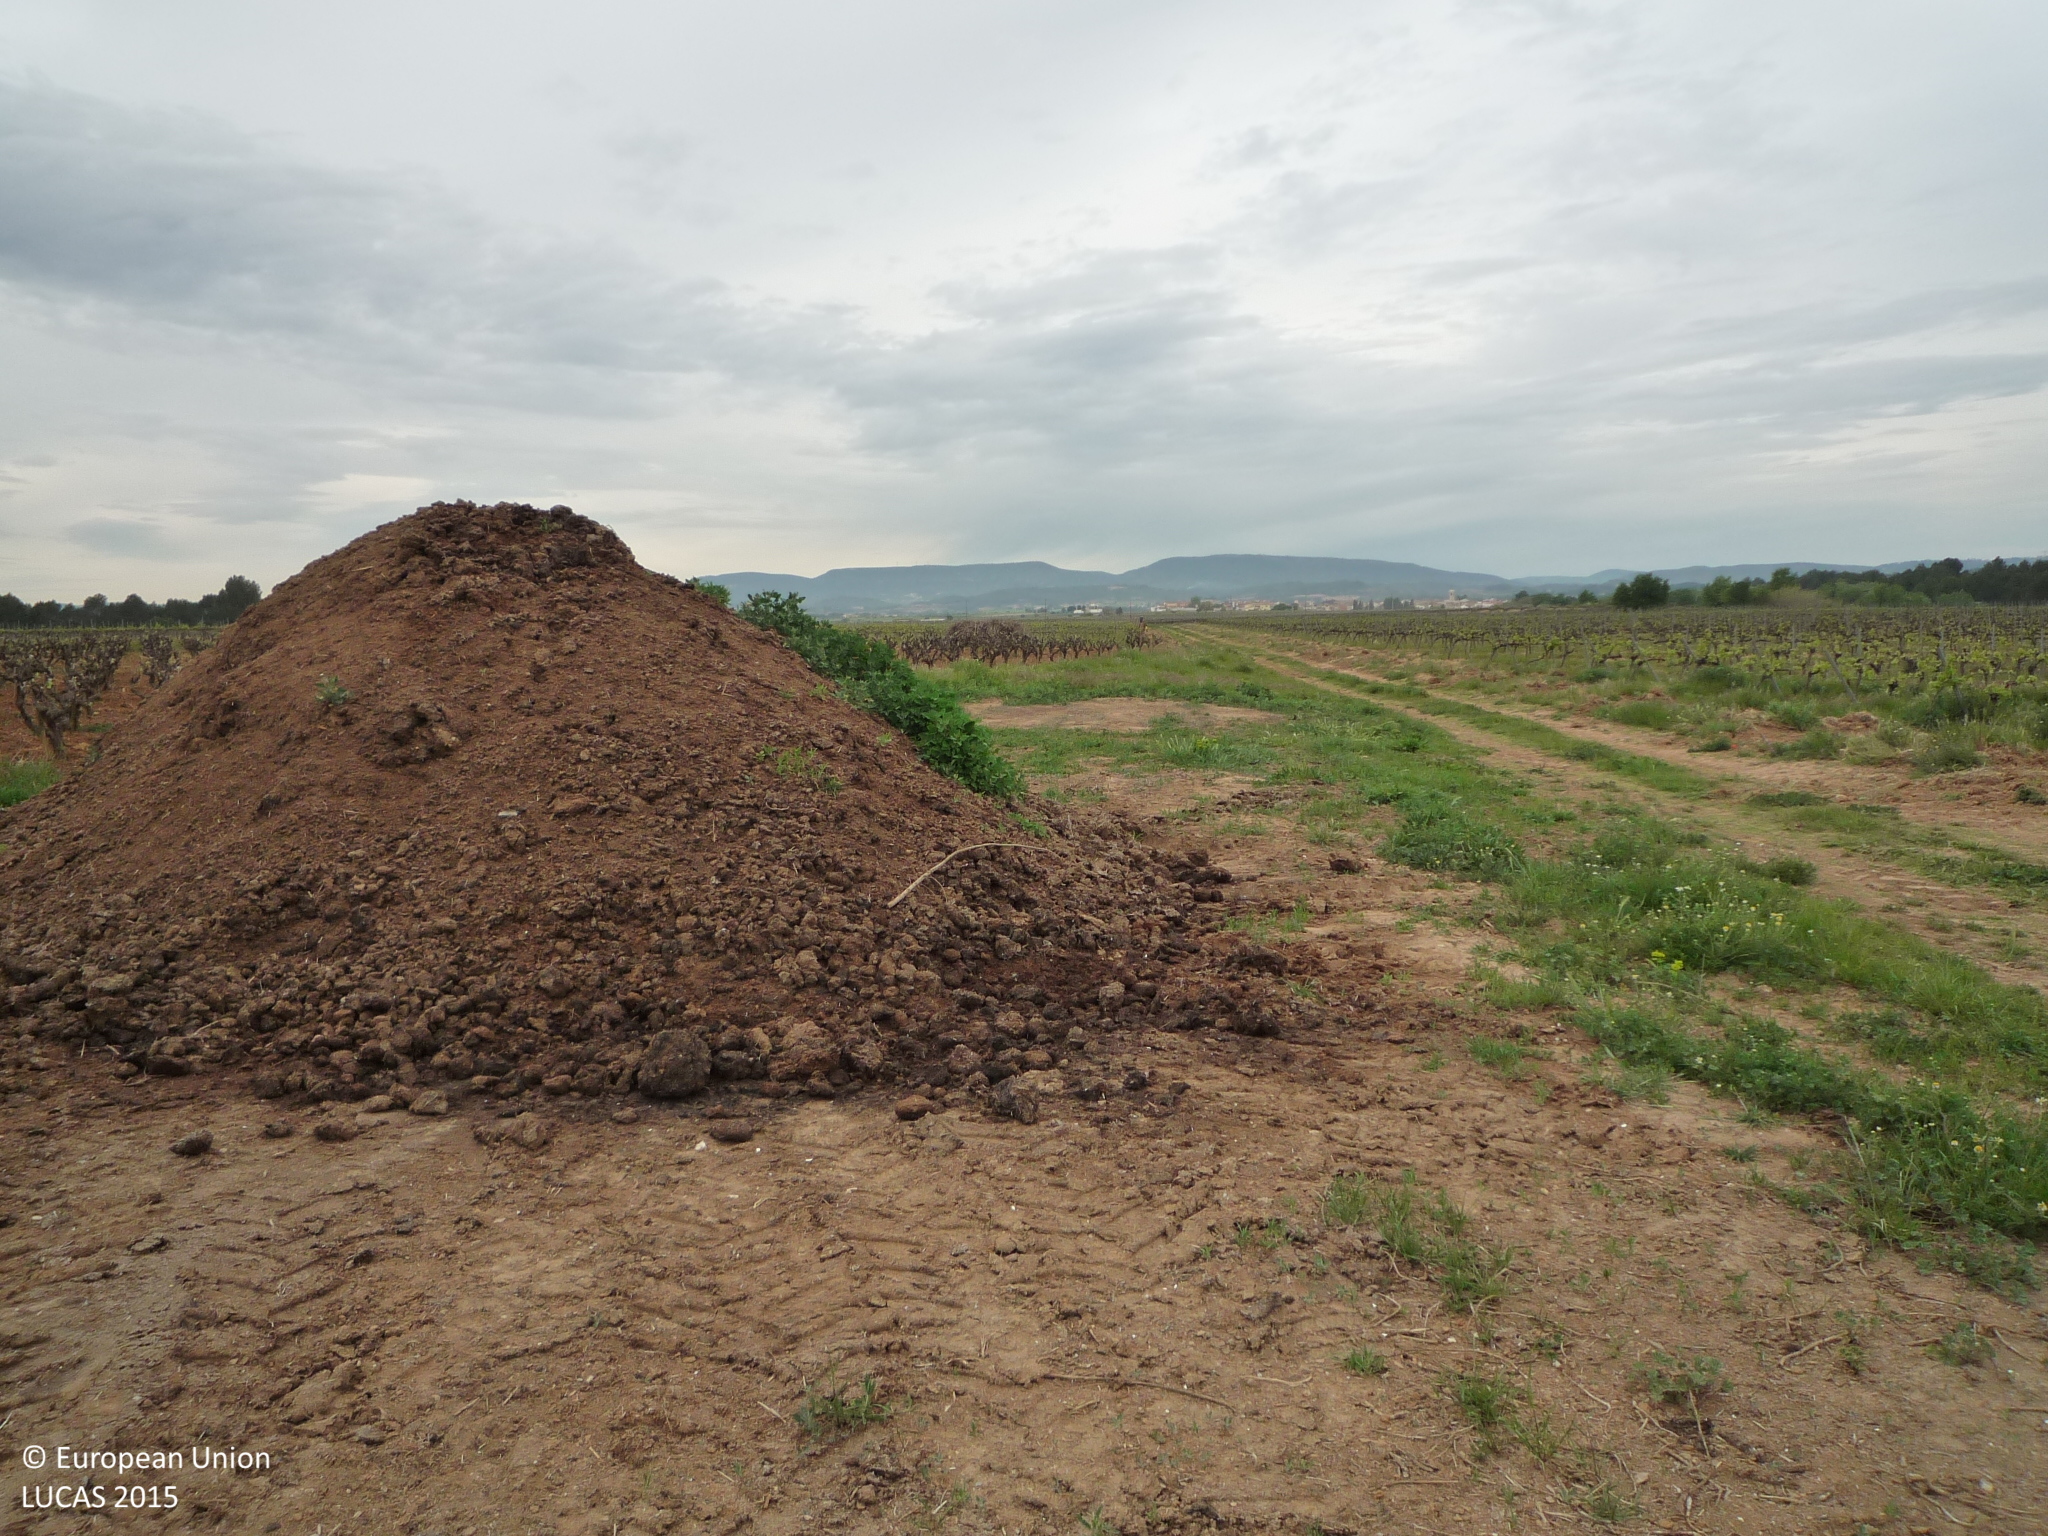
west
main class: Grassland
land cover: Grassland without tree/shrub cover
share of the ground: > 75 %
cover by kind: herbaceous plants 100 %
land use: Abandoned areas
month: April
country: ES
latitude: 41.4075
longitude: 1.7270
